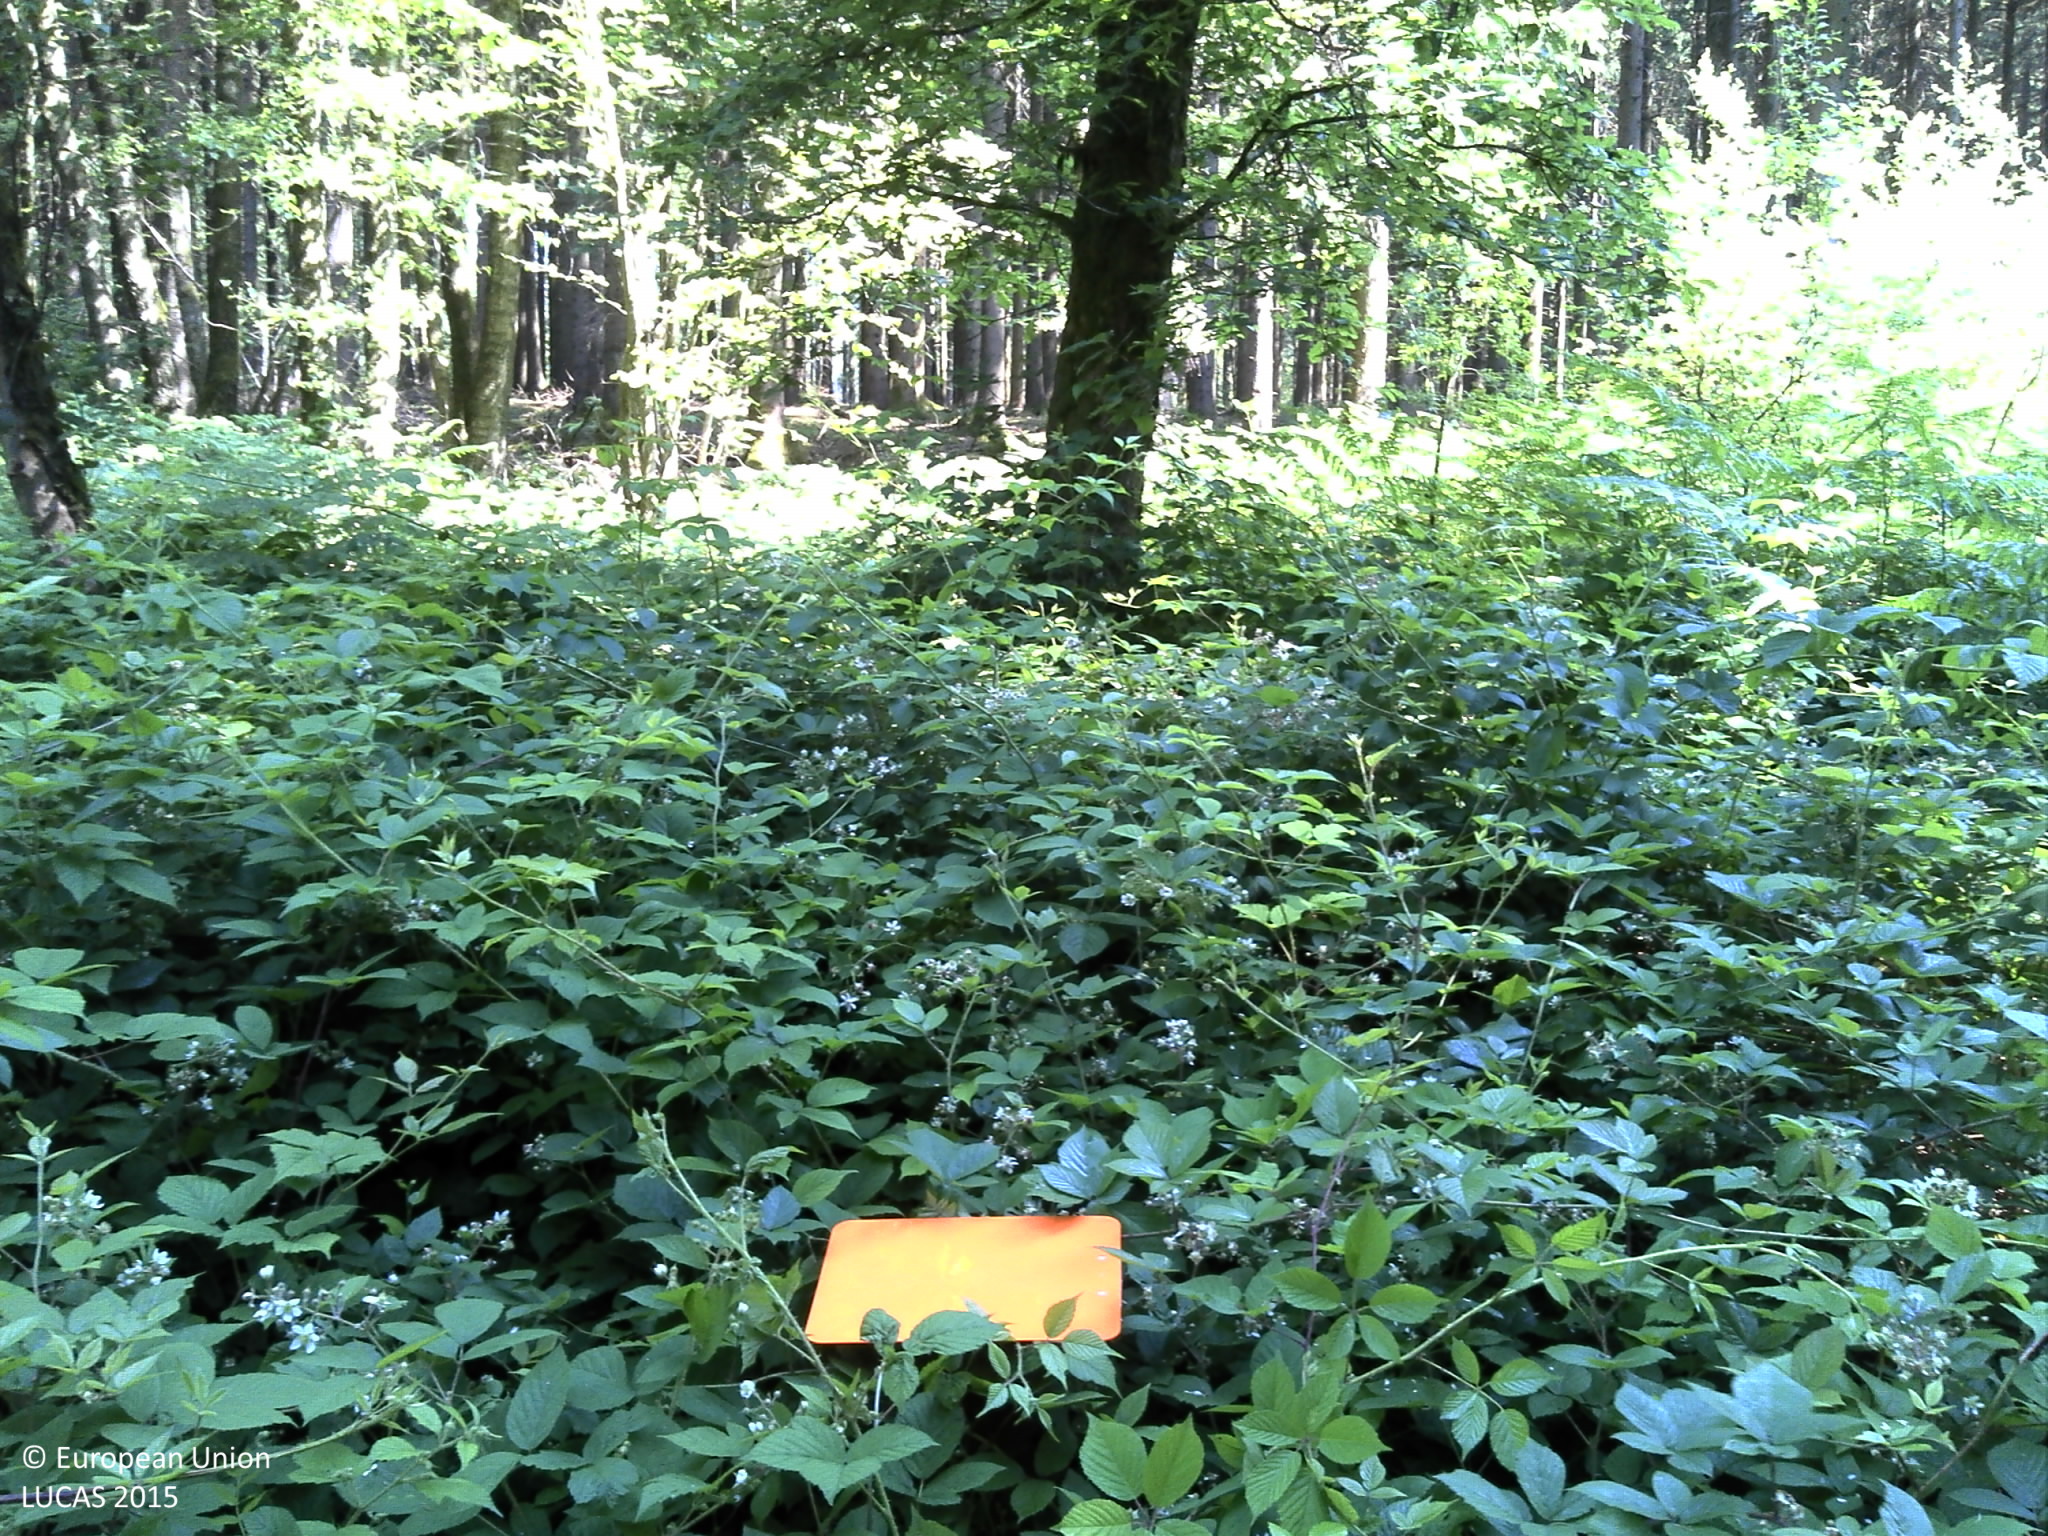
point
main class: Woodland
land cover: Spruce dominated coniferous woodland
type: alpine coniferous forest
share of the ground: 50 - 75 %
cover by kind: coniferous forest trees 70 %, herbaceous plants 20 %, lichens and mosses 10 %
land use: Forestry
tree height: > 5 m
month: July
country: FR
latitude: 49.9138
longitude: 4.6348
